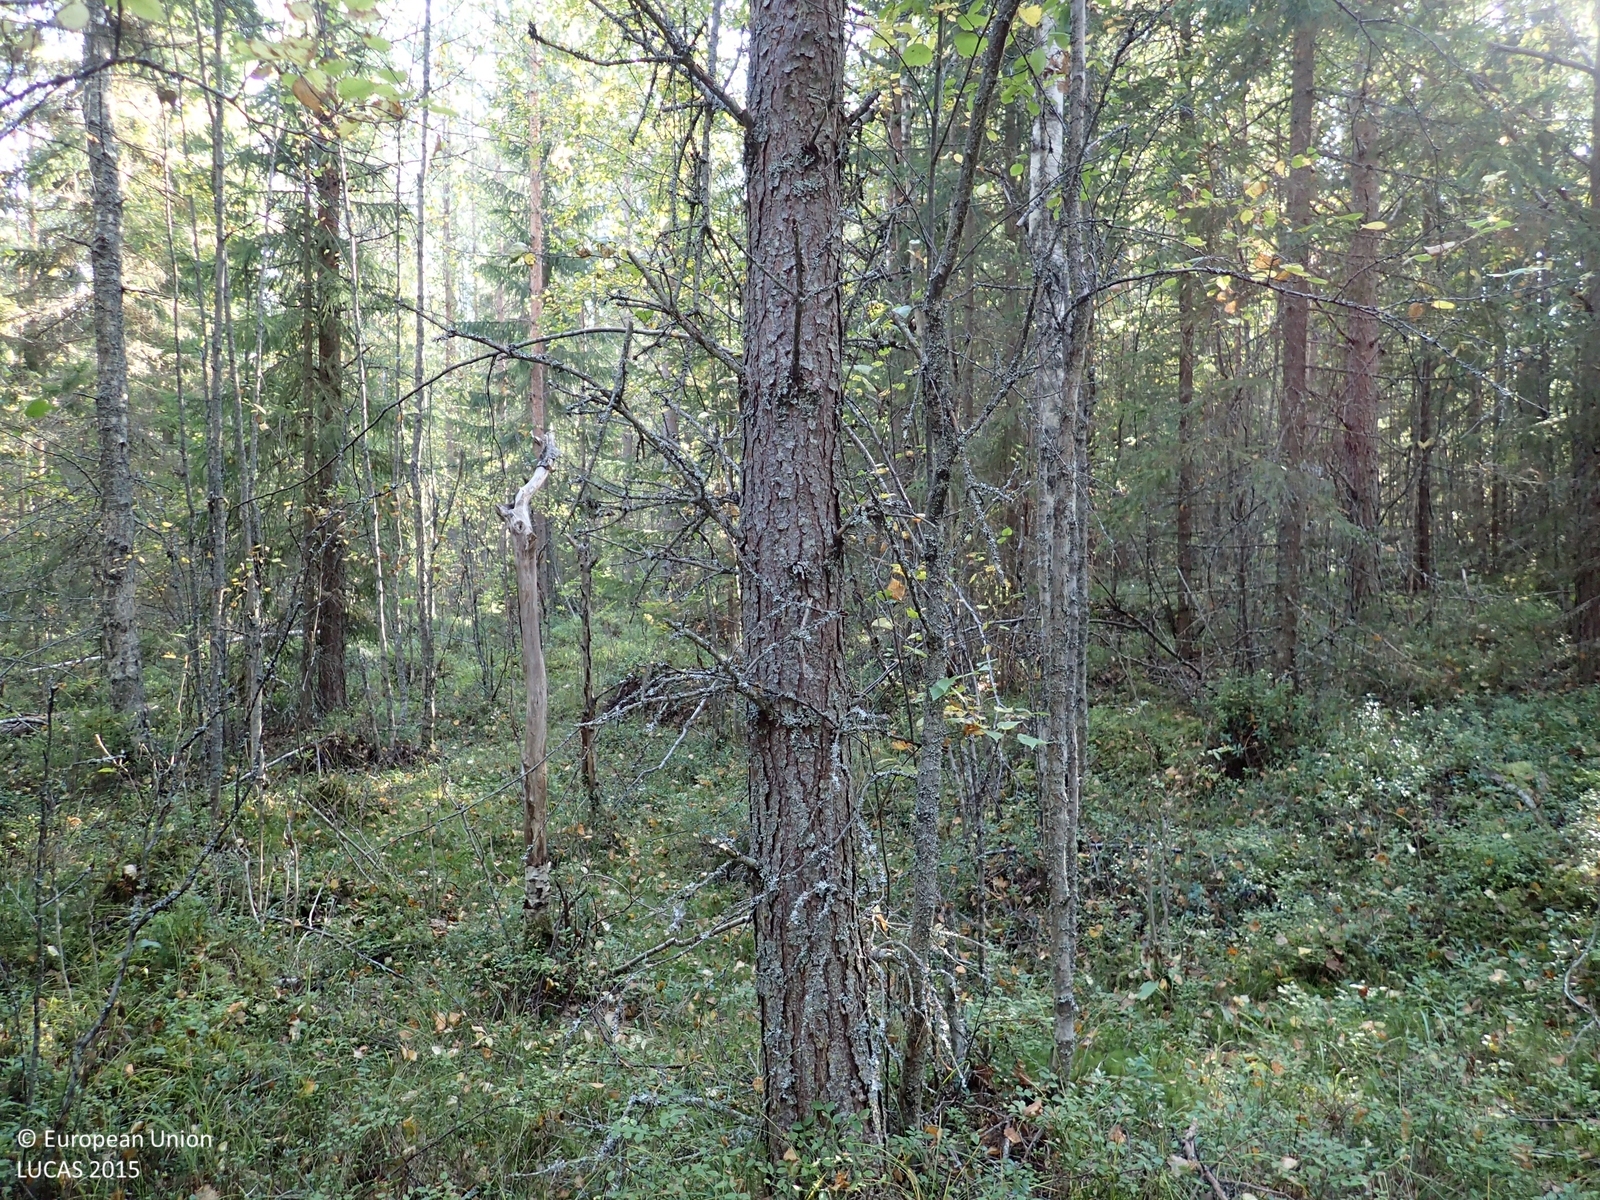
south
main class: Woodland
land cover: Spruce dominated coniferous woodland
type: boreal forest
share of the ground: > 75 %
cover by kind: coniferous forest trees 70 %, shrubs 15 %, broadleaved forest trees 10 %, lichens and mosses 5 %
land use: Forestry
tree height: > 5 m
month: September
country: FI
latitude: 62.9075
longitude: 25.5187
